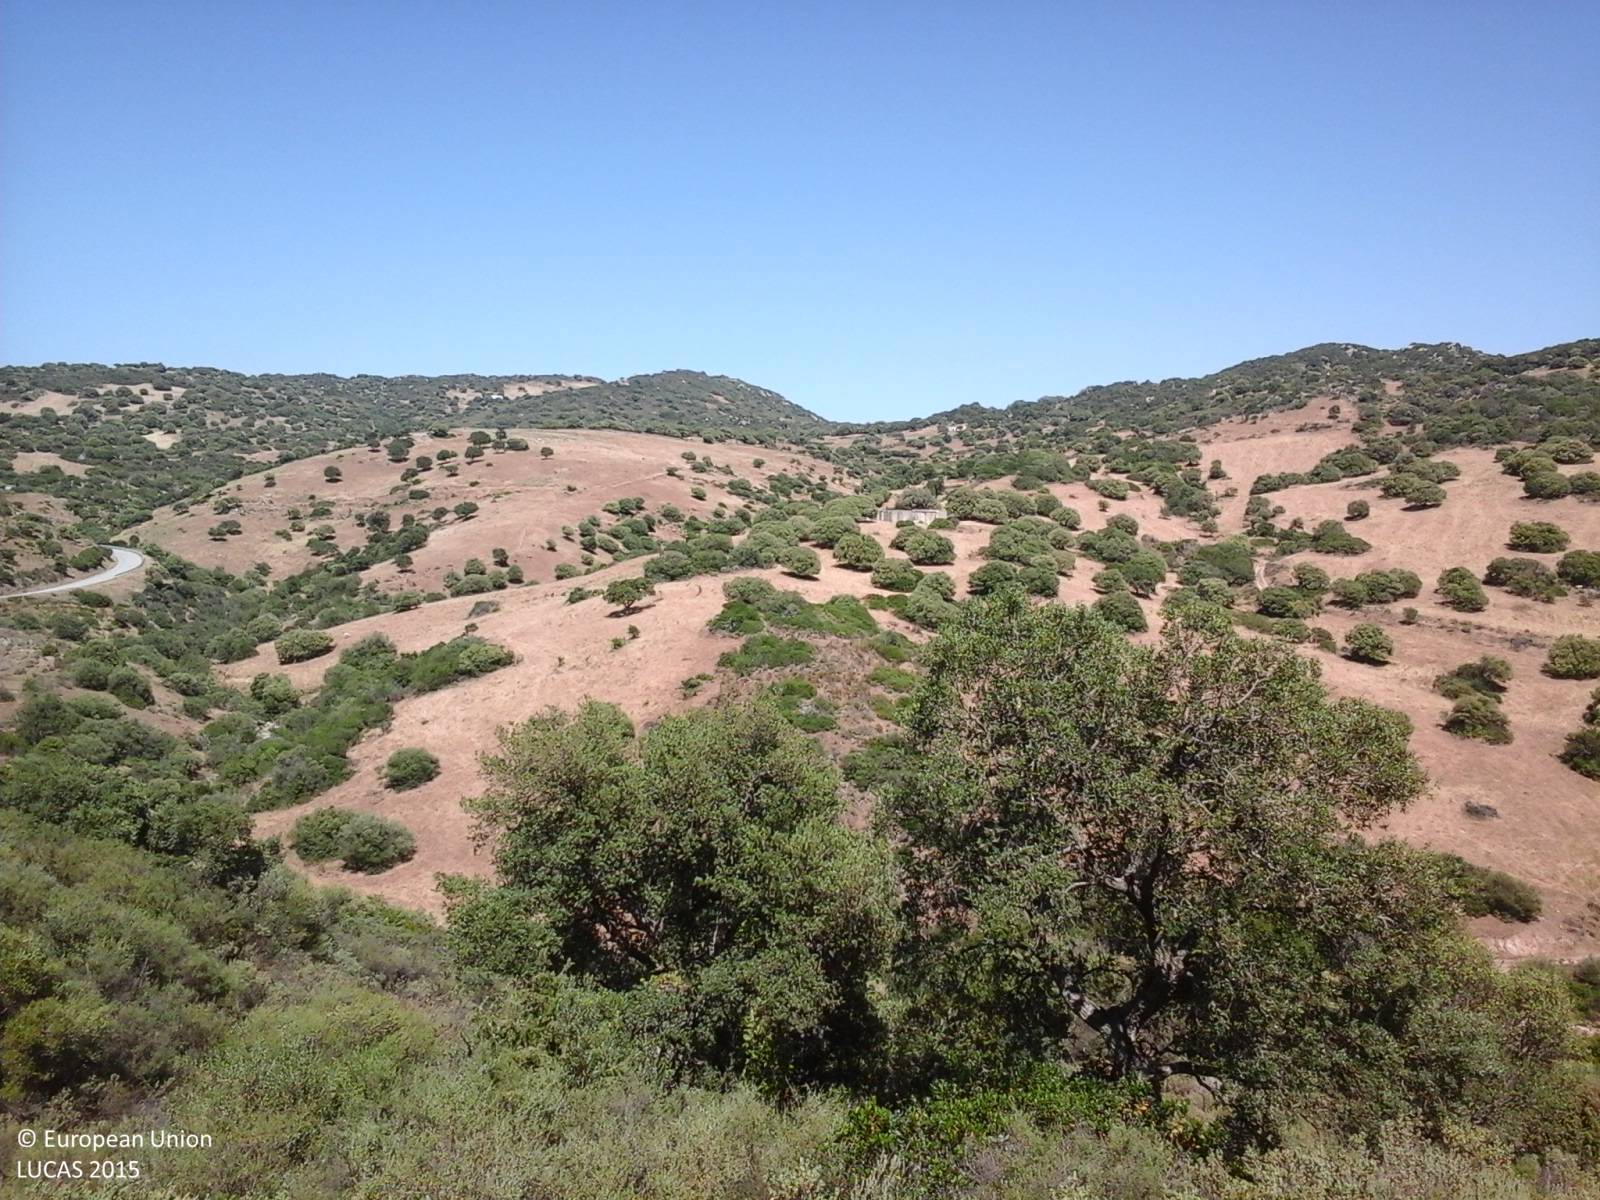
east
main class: Shrubland
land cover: Shrubland without tree cover
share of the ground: > 75 %
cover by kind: shrubs 95 %, herbaceous plants 5 %
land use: Semi-natural and natural areas not in use
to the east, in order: Shrubland without tree cover; Grassland without tree/shrub cover; Paved roads, cycling and walking lanes; Shrubland without tree cover
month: May
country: IT
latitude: 40.3381
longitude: 9.4262
